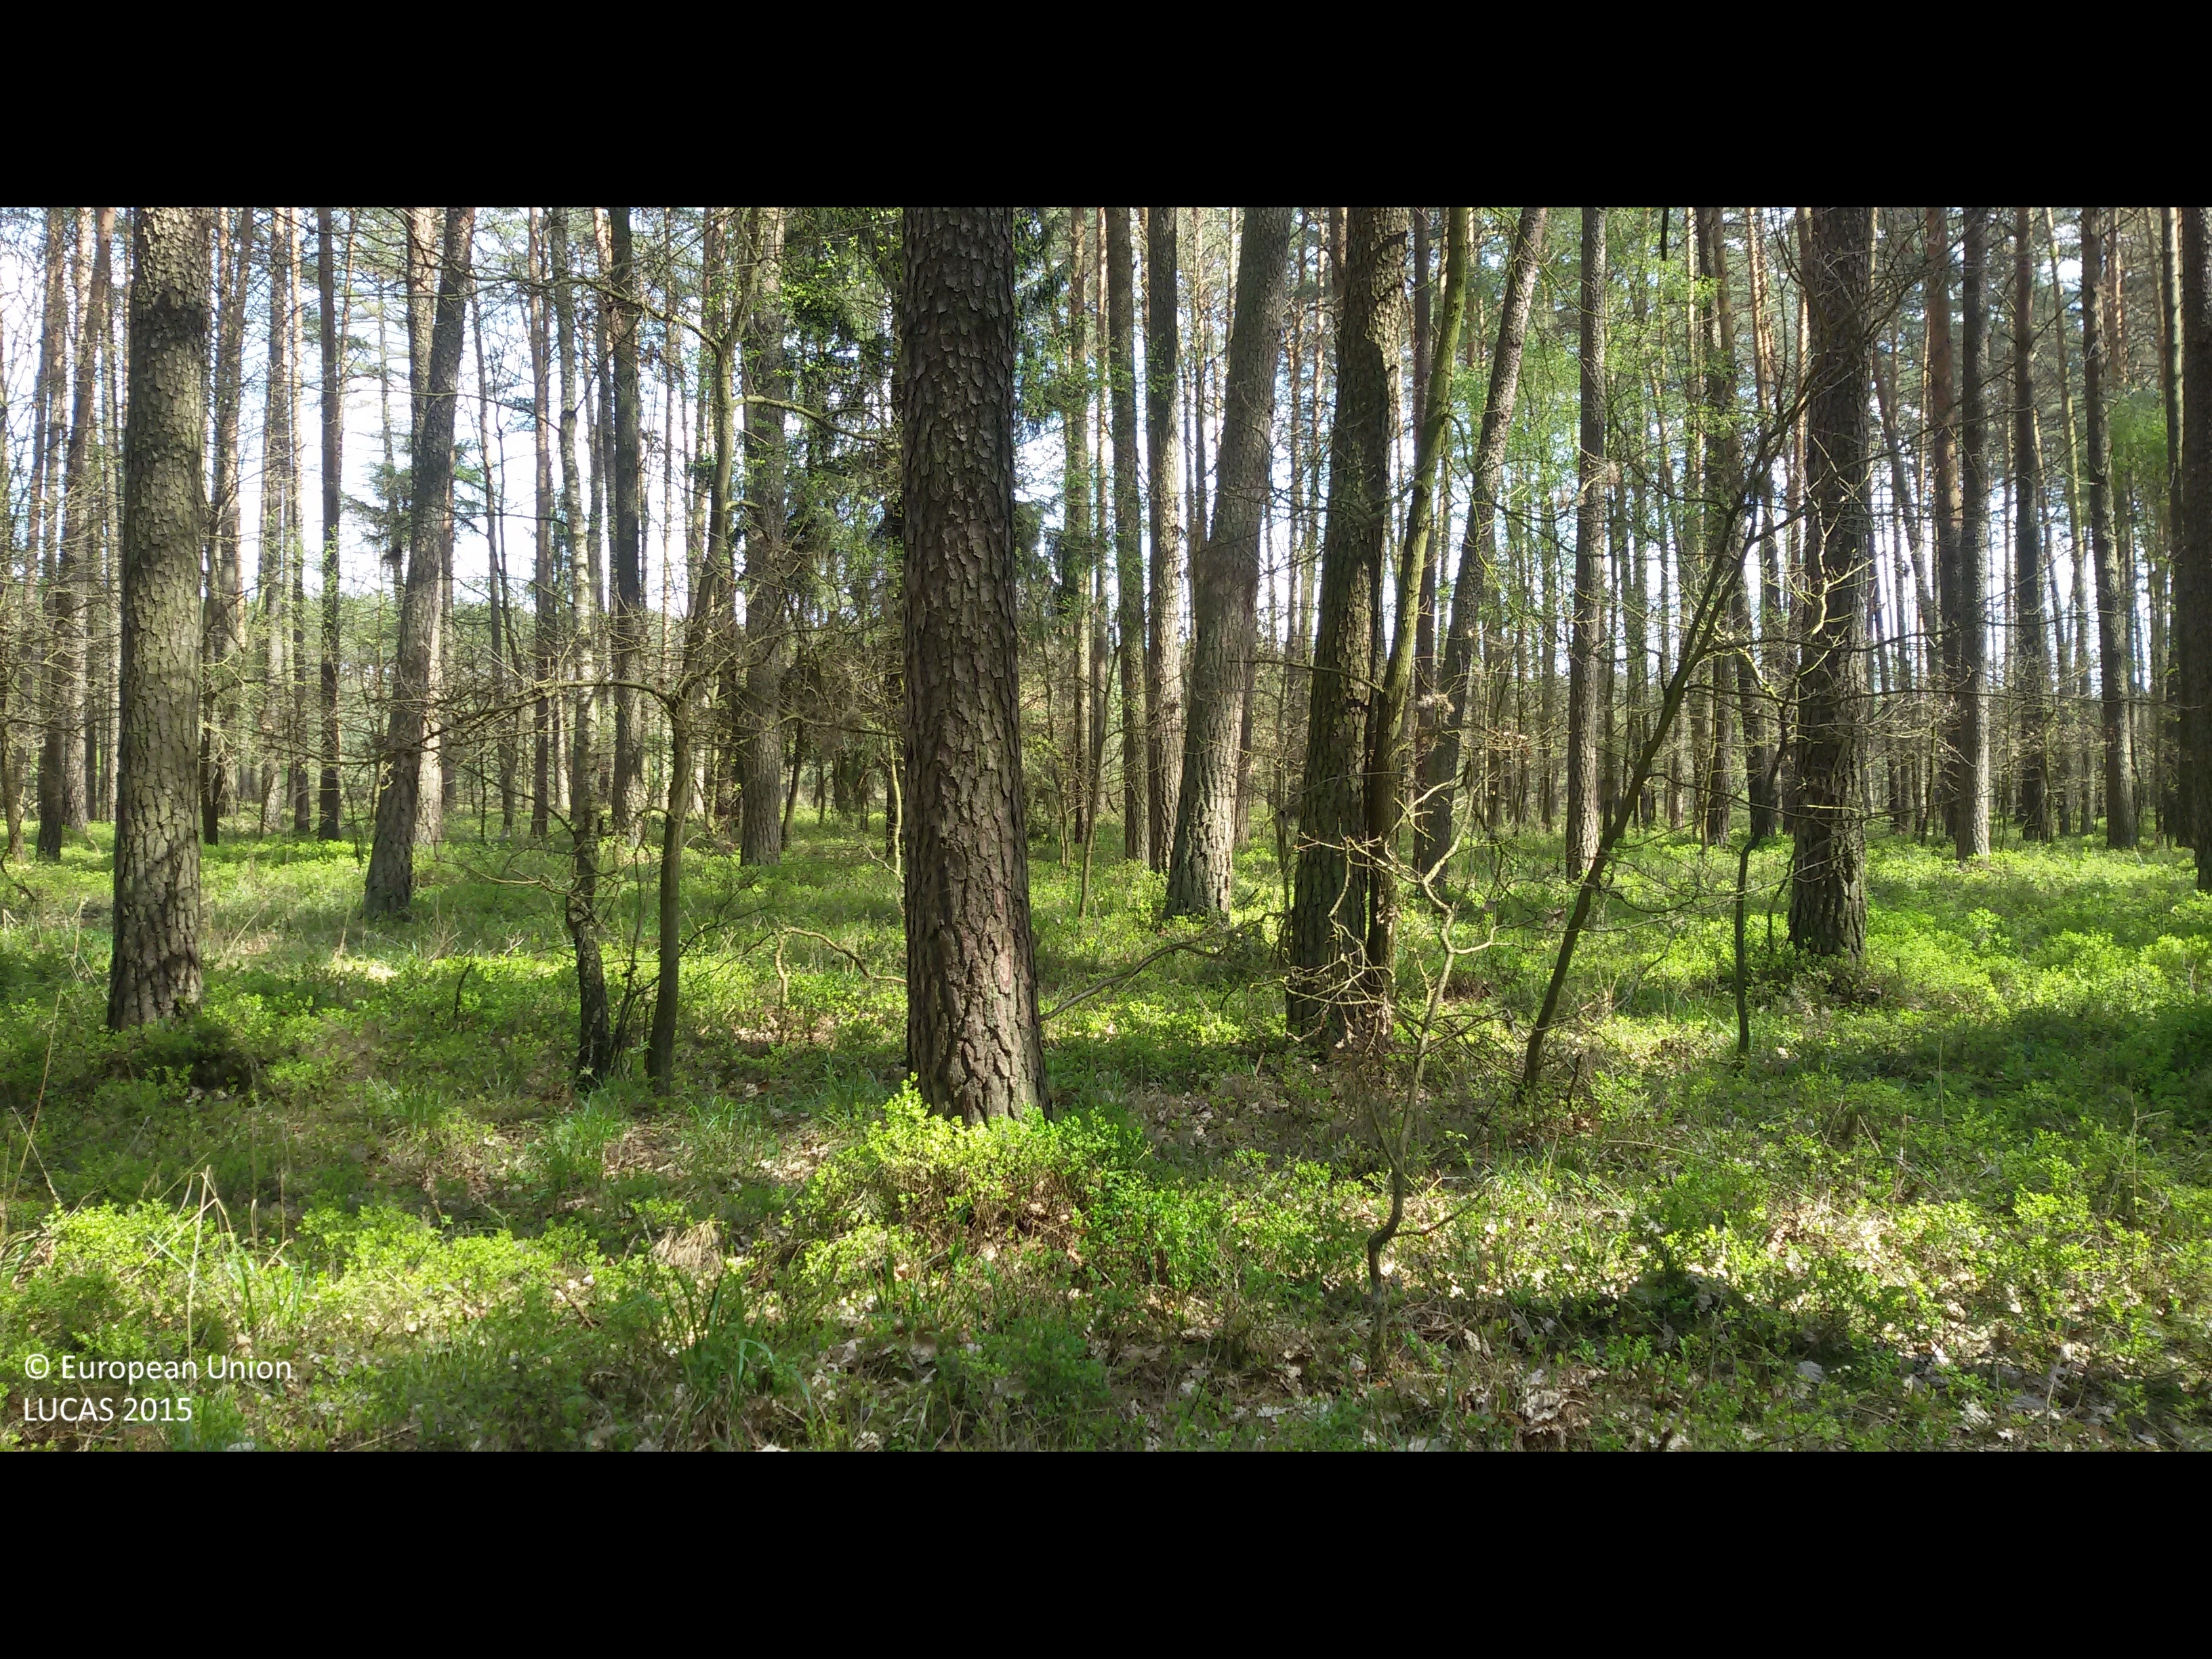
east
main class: Woodland
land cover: Pine dominated mixed woodland
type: hemiboreal forest and nemoral coniferous forest and mixed broadleaved-coniferous forest
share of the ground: > 75 %
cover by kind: coniferous forest trees 60 %, broadleaved forest trees 25 %, herbaceous plants 10 %, shrubs 5 %
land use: Forestry
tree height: > 5 m
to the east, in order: Pine dominated mixed woodland; Tracks; Pine dominated coniferous woodland; Tracks; Pine dominated coniferous woodland; Tracks; Pine dominated coniferous woodland
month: May
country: PL
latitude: 52.9099
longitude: 17.0132
